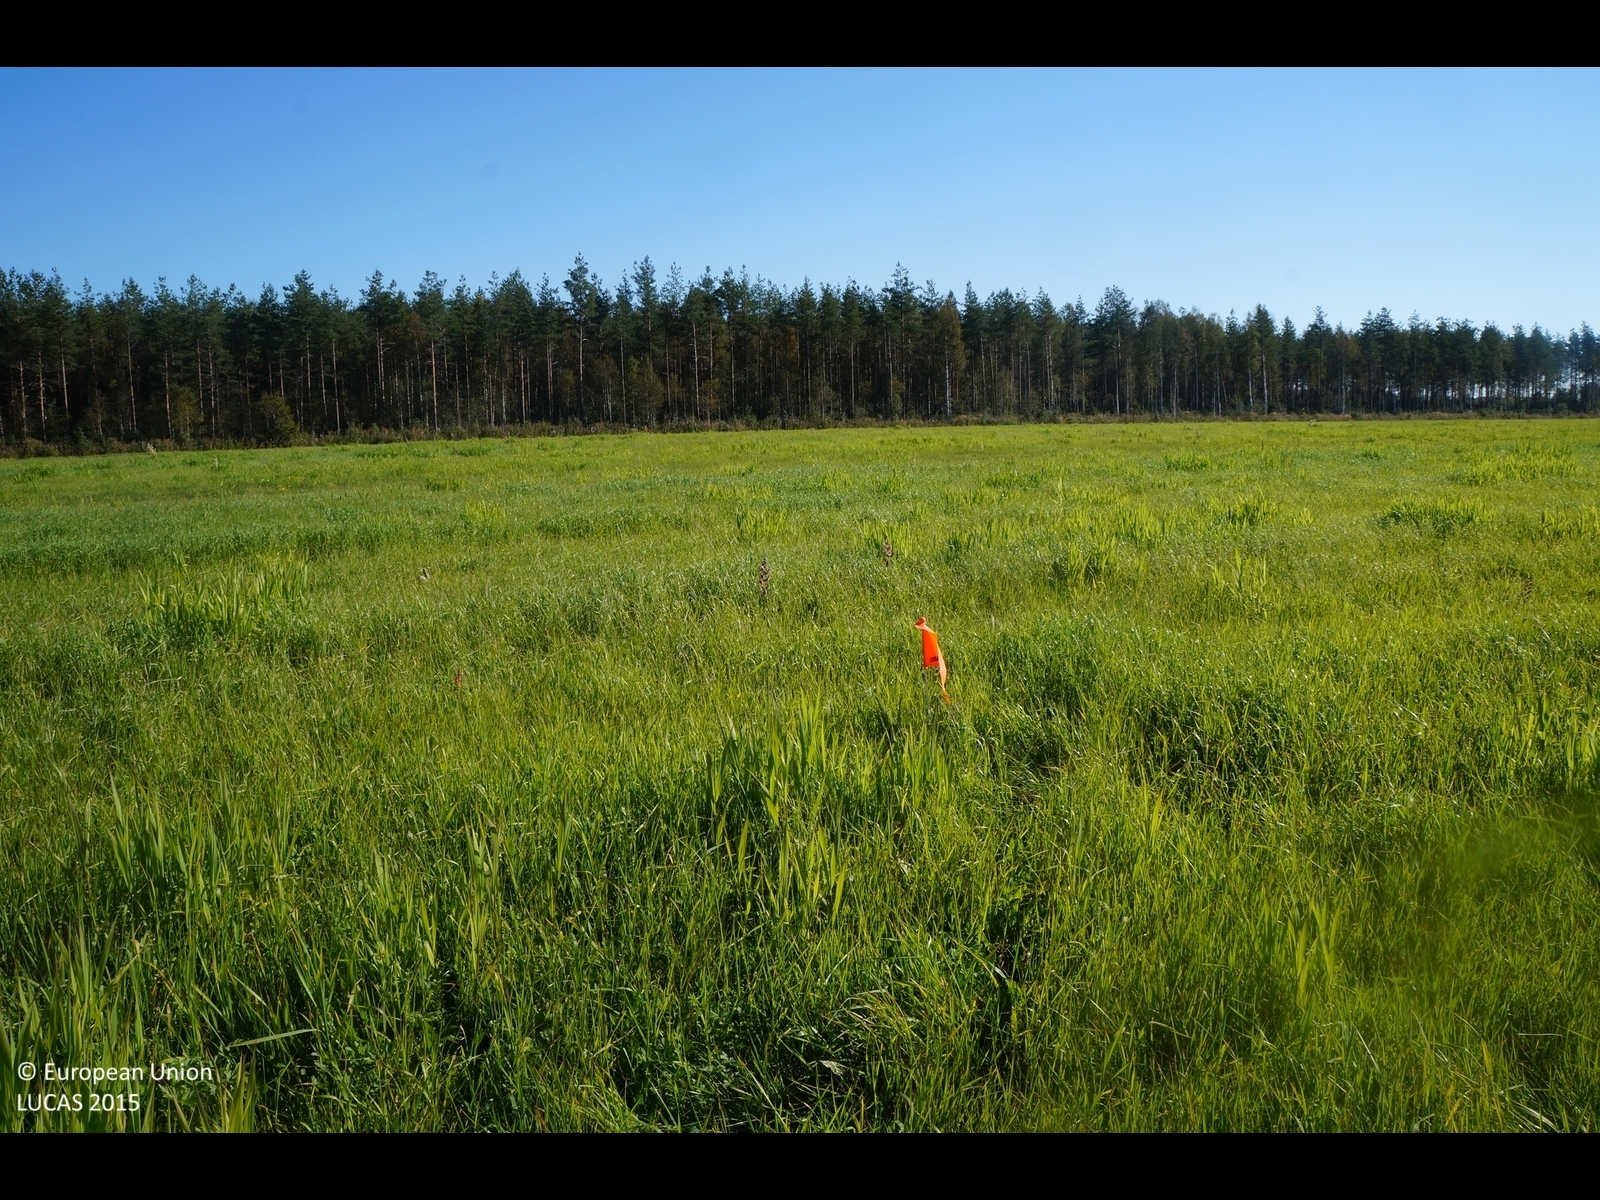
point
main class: Cropland
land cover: Temporary grasslands
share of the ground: > 75 %
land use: Agriculture (excluding fallow land and kitchen gardens)
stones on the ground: < 10 %
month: August
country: FI
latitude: 64.3454
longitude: 25.1761
